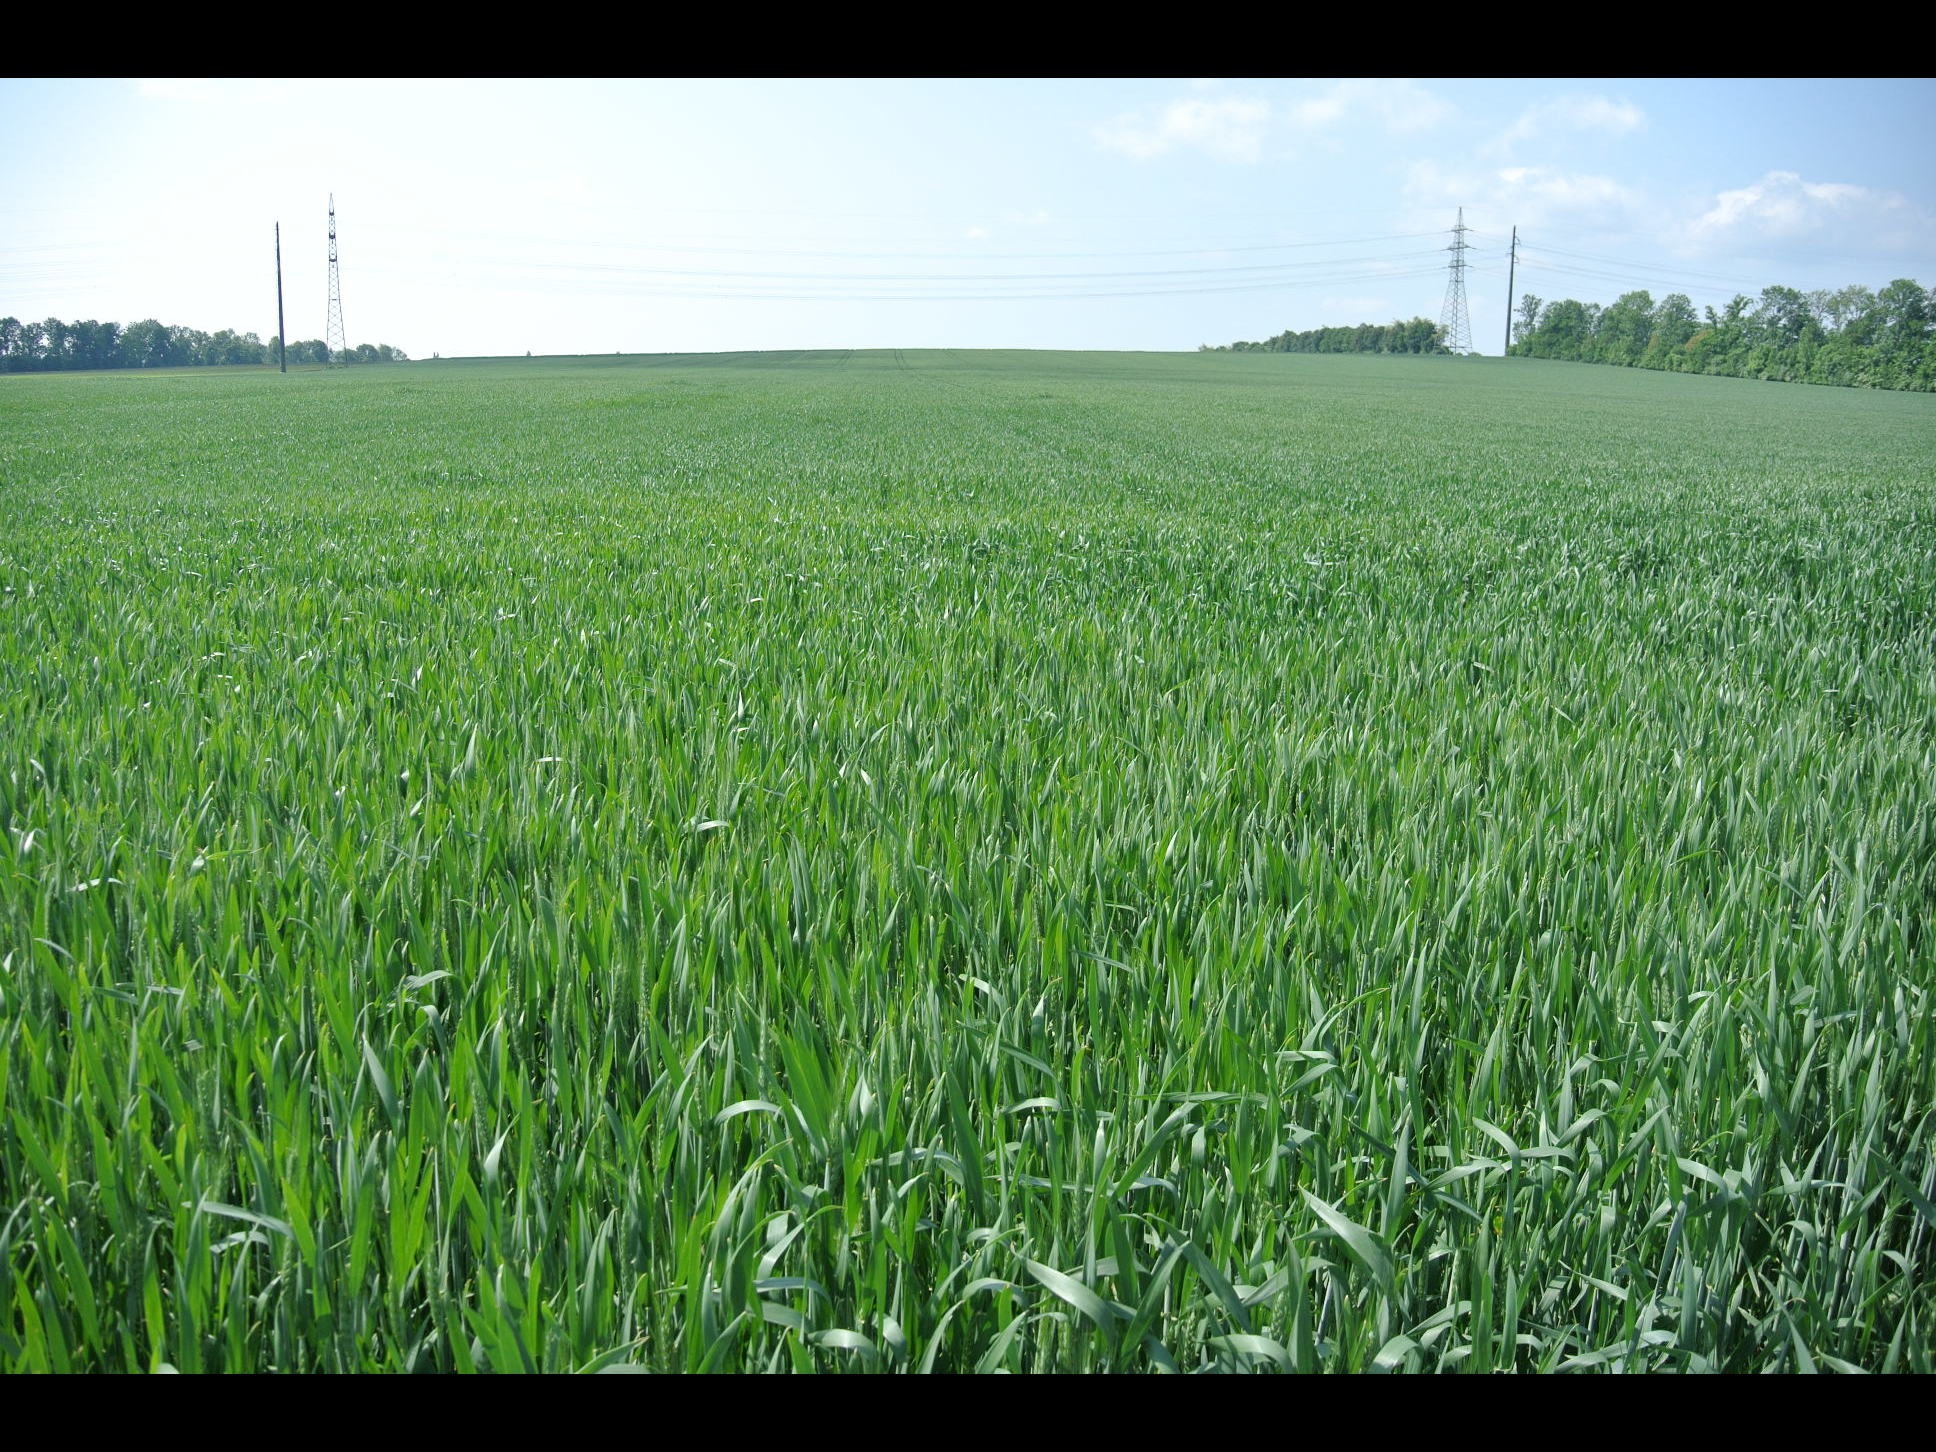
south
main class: Cropland
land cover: Triticale
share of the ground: > 75 %
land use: Agriculture (excluding fallow land and kitchen gardens)
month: May
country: AT
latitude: 48.0345
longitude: 16.7521
